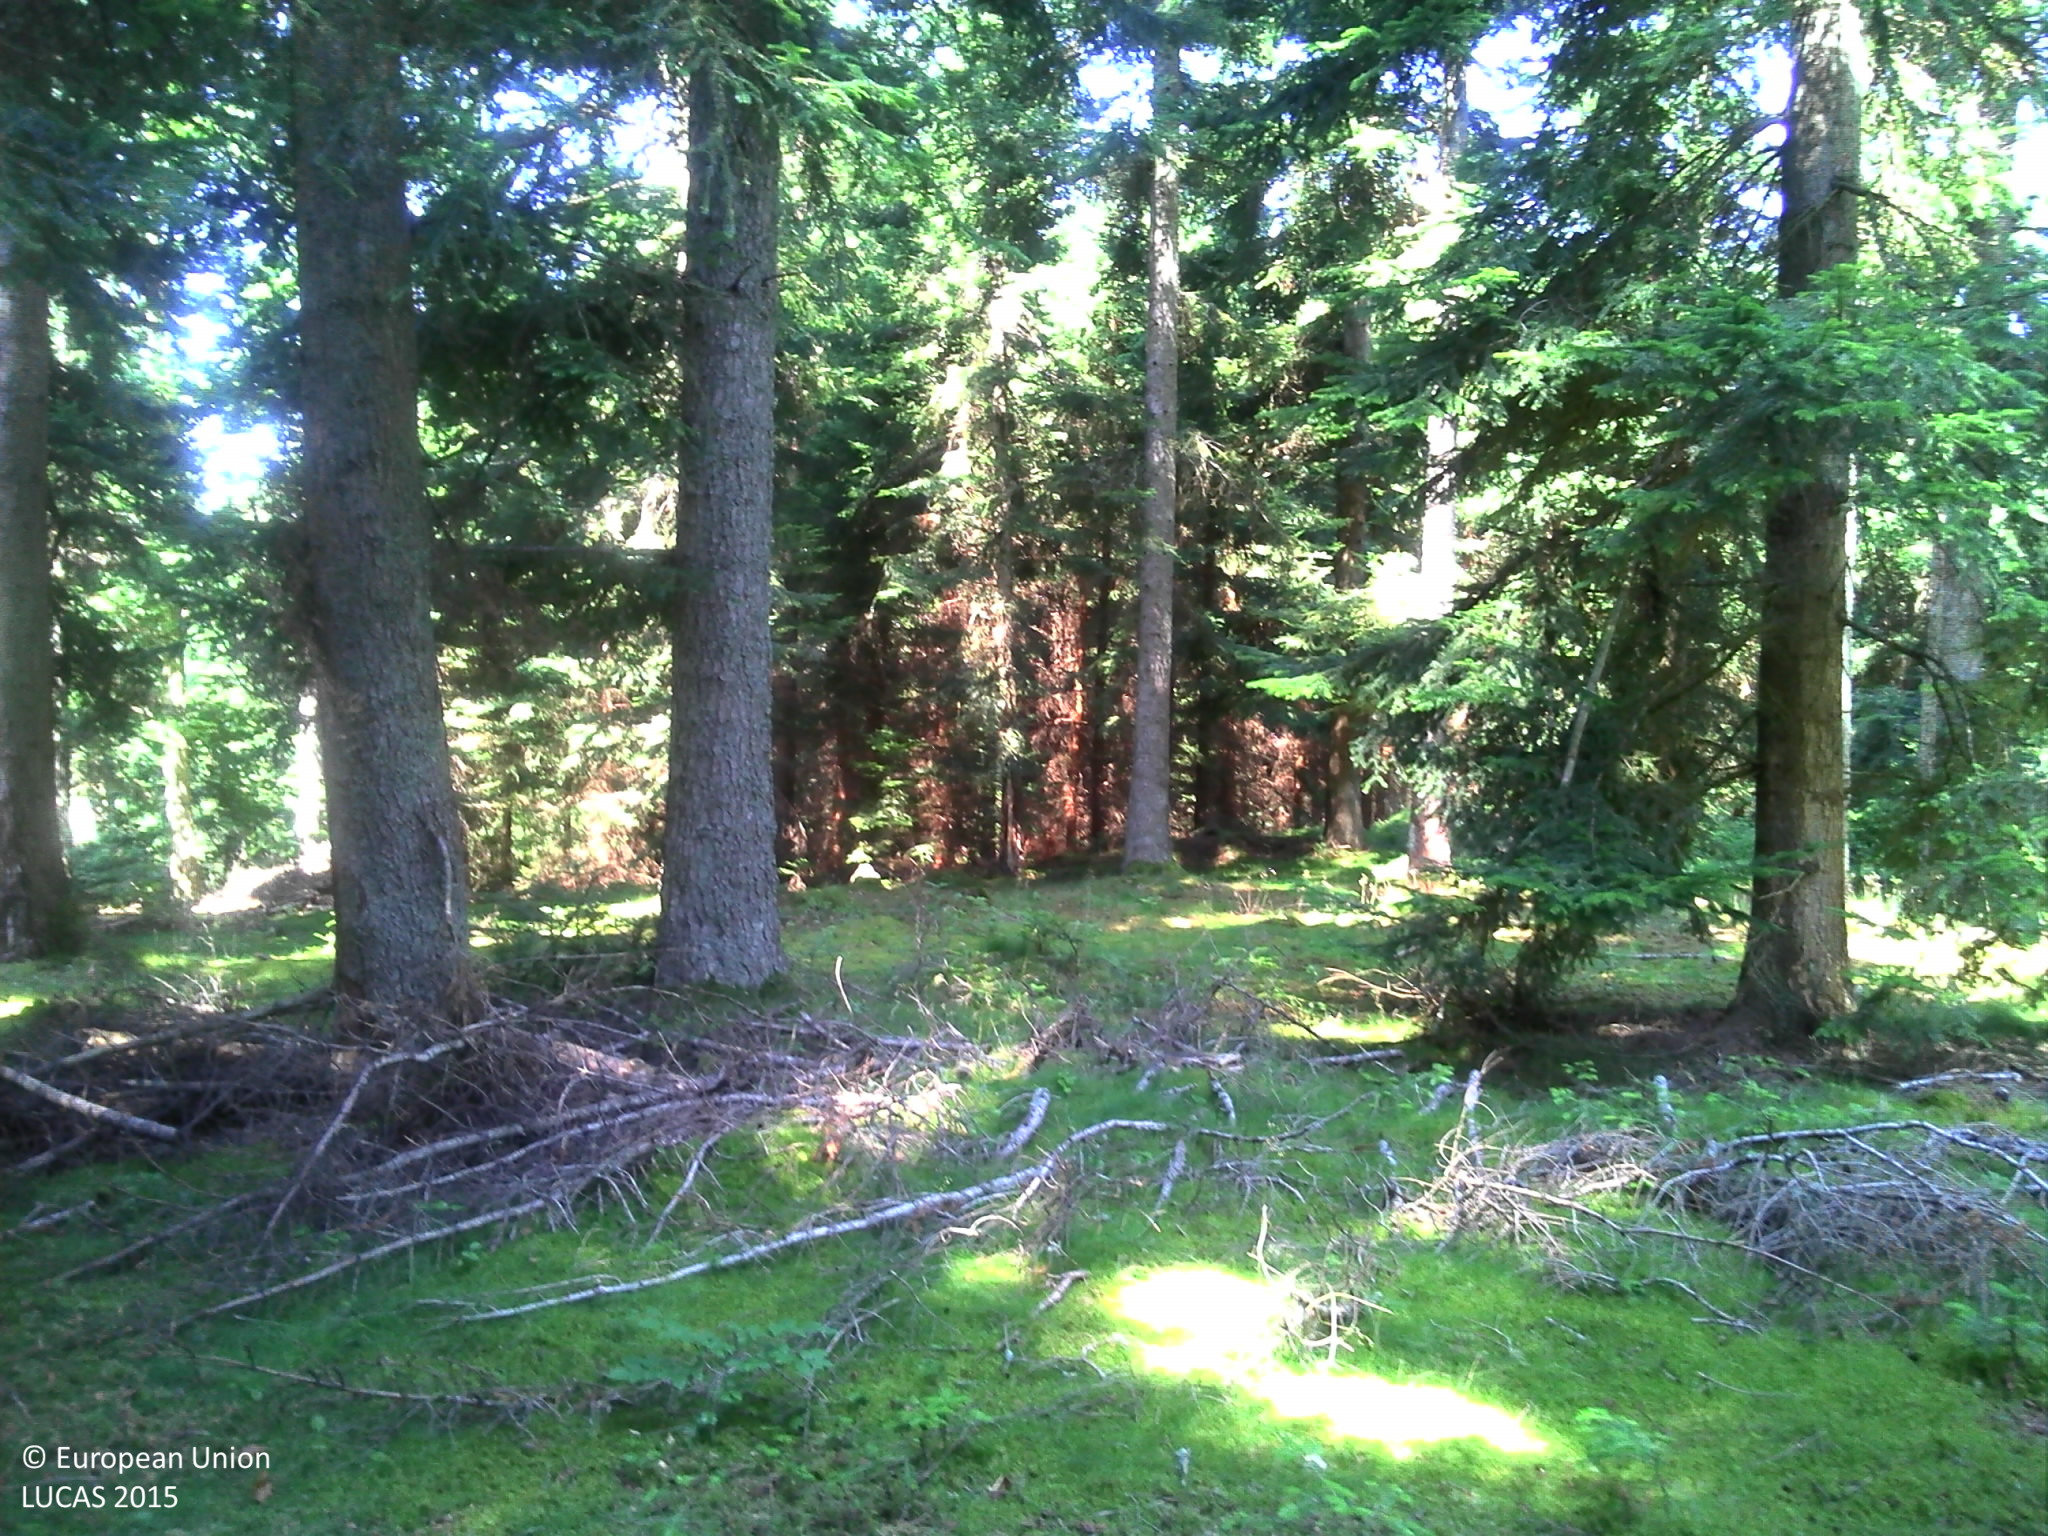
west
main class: Woodland
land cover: Other coniferous woodland
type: alpine coniferous forest
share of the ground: > 75 %
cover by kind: coniferous forest trees 85 %, shrubs 10 %, herbaceous plants 5 %
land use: Forestry
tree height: > 5 m
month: July
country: FR
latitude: 45.0588
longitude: 4.2521
